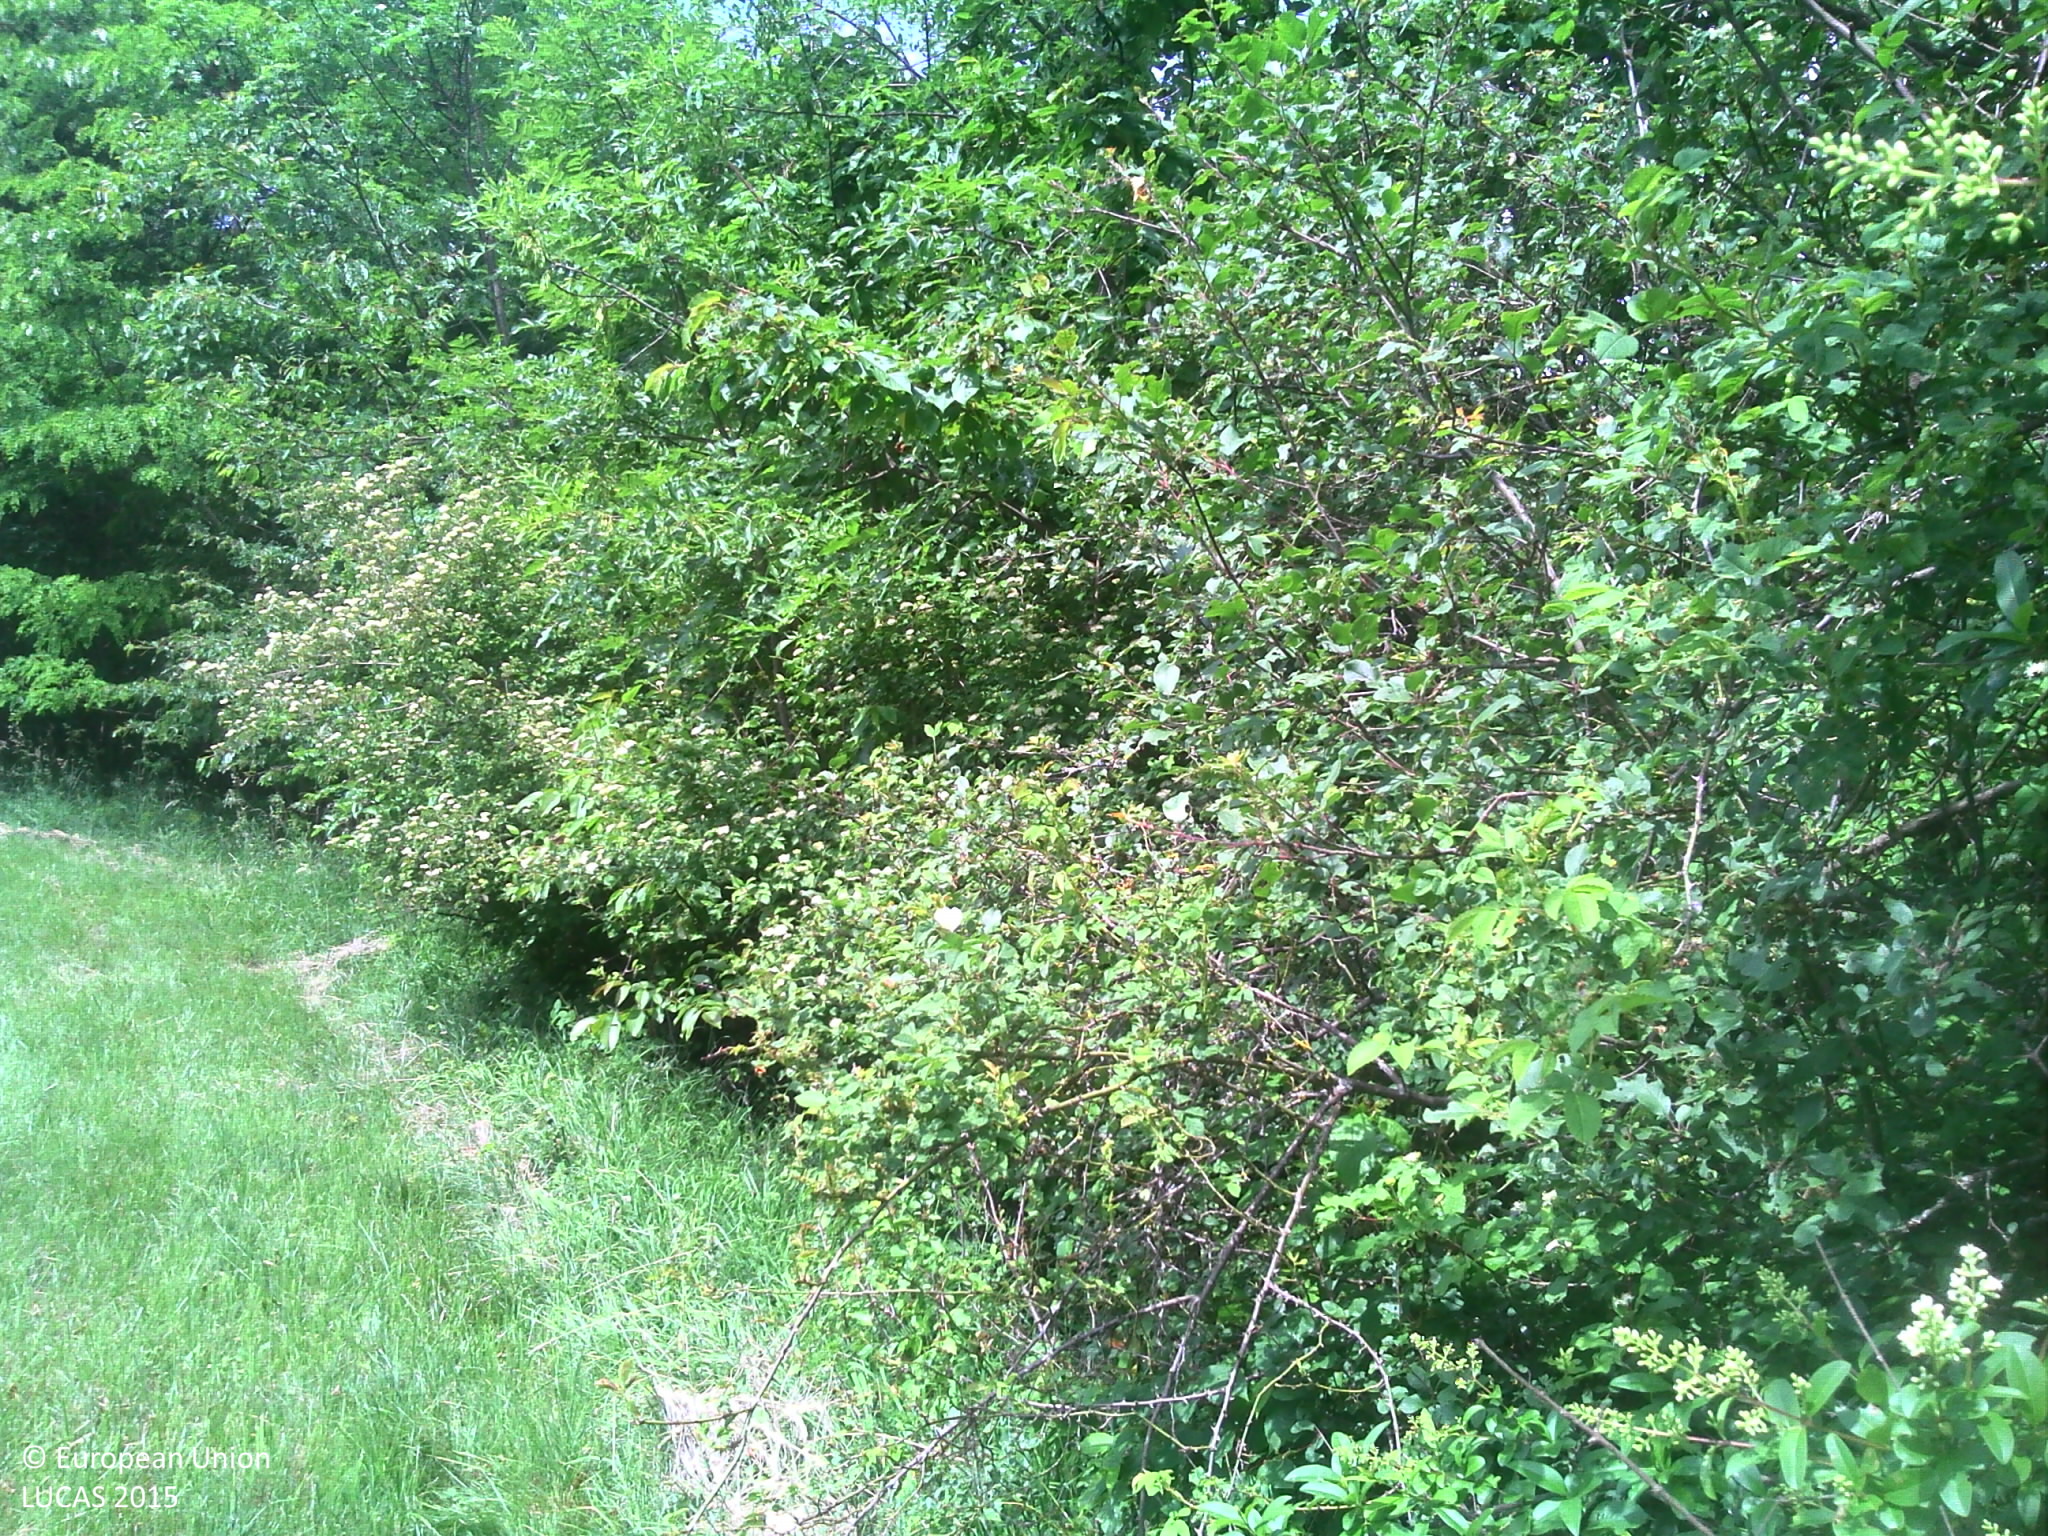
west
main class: Woodland
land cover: Broadleaved woodland
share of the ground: > 75 %
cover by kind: broadleaved forest trees 100 %
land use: Forestry
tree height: < 5 m
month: May
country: FR
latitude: 48.6630
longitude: 7.4890
